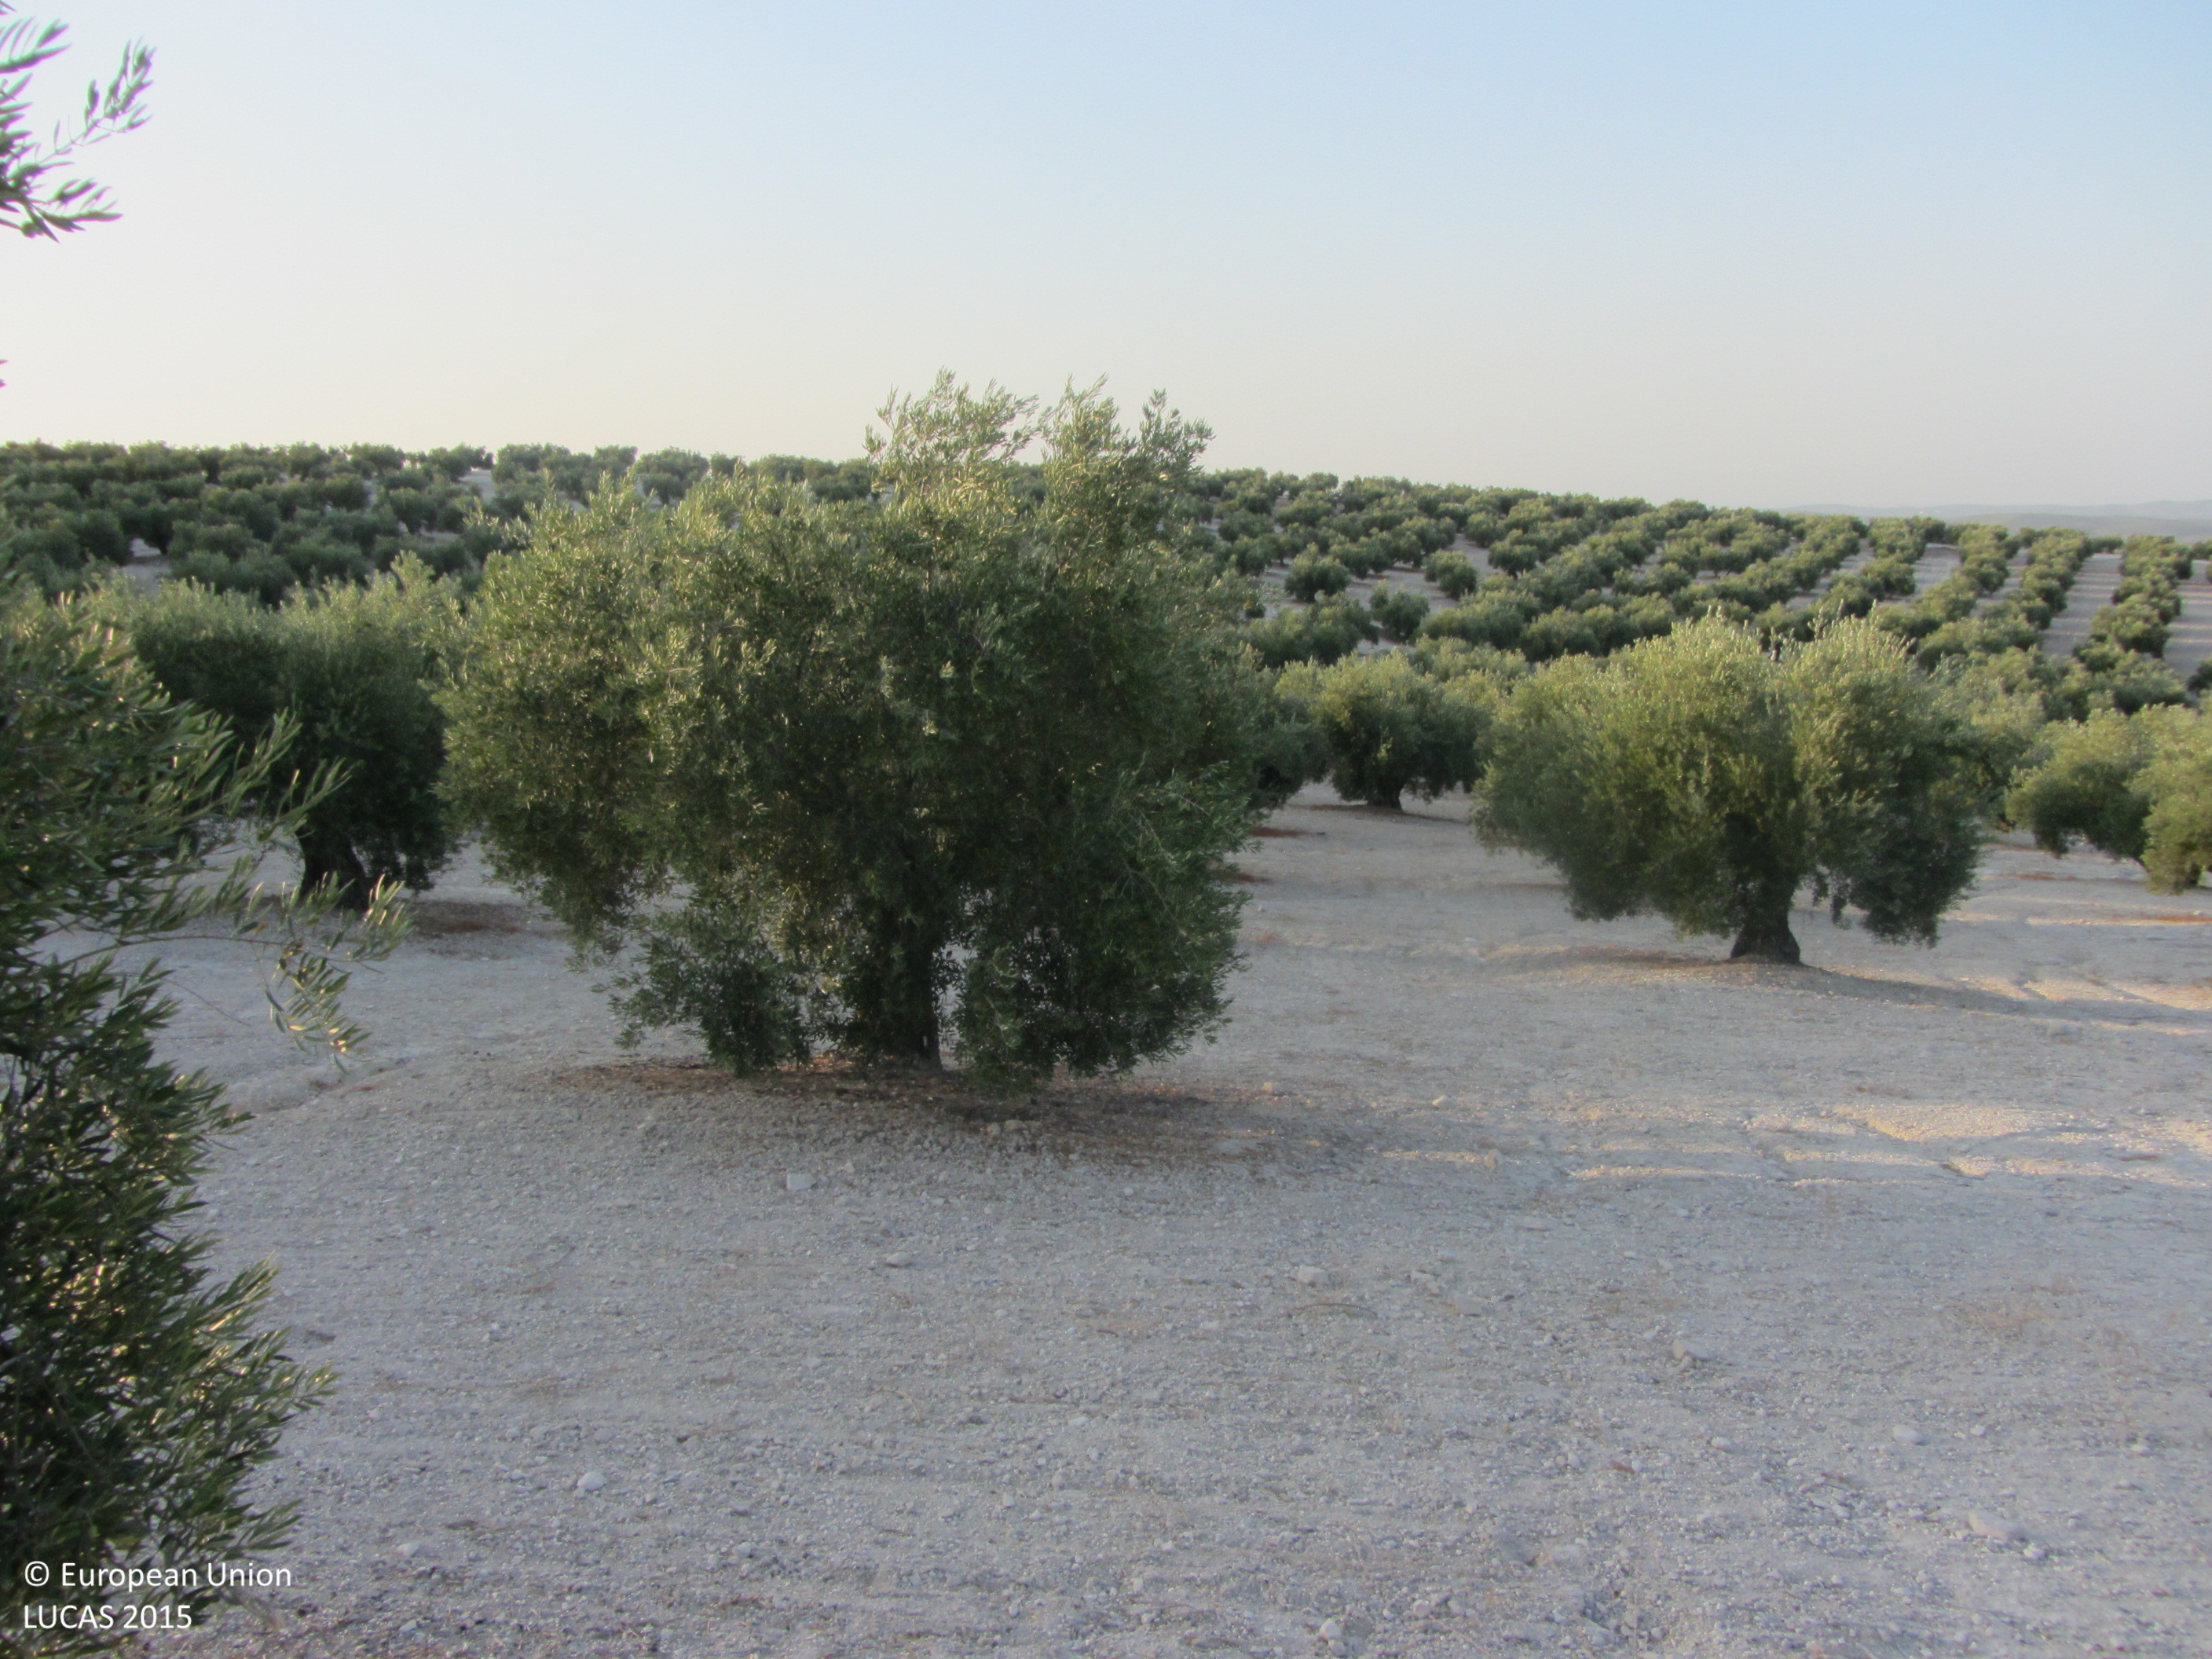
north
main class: Cropland
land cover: Olive groves
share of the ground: 10 - 25 %
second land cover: Other bare soil
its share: > 75 %
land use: Agriculture (excluding fallow land and kitchen gardens)
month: July
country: ES
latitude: 37.7840
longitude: -4.1643
